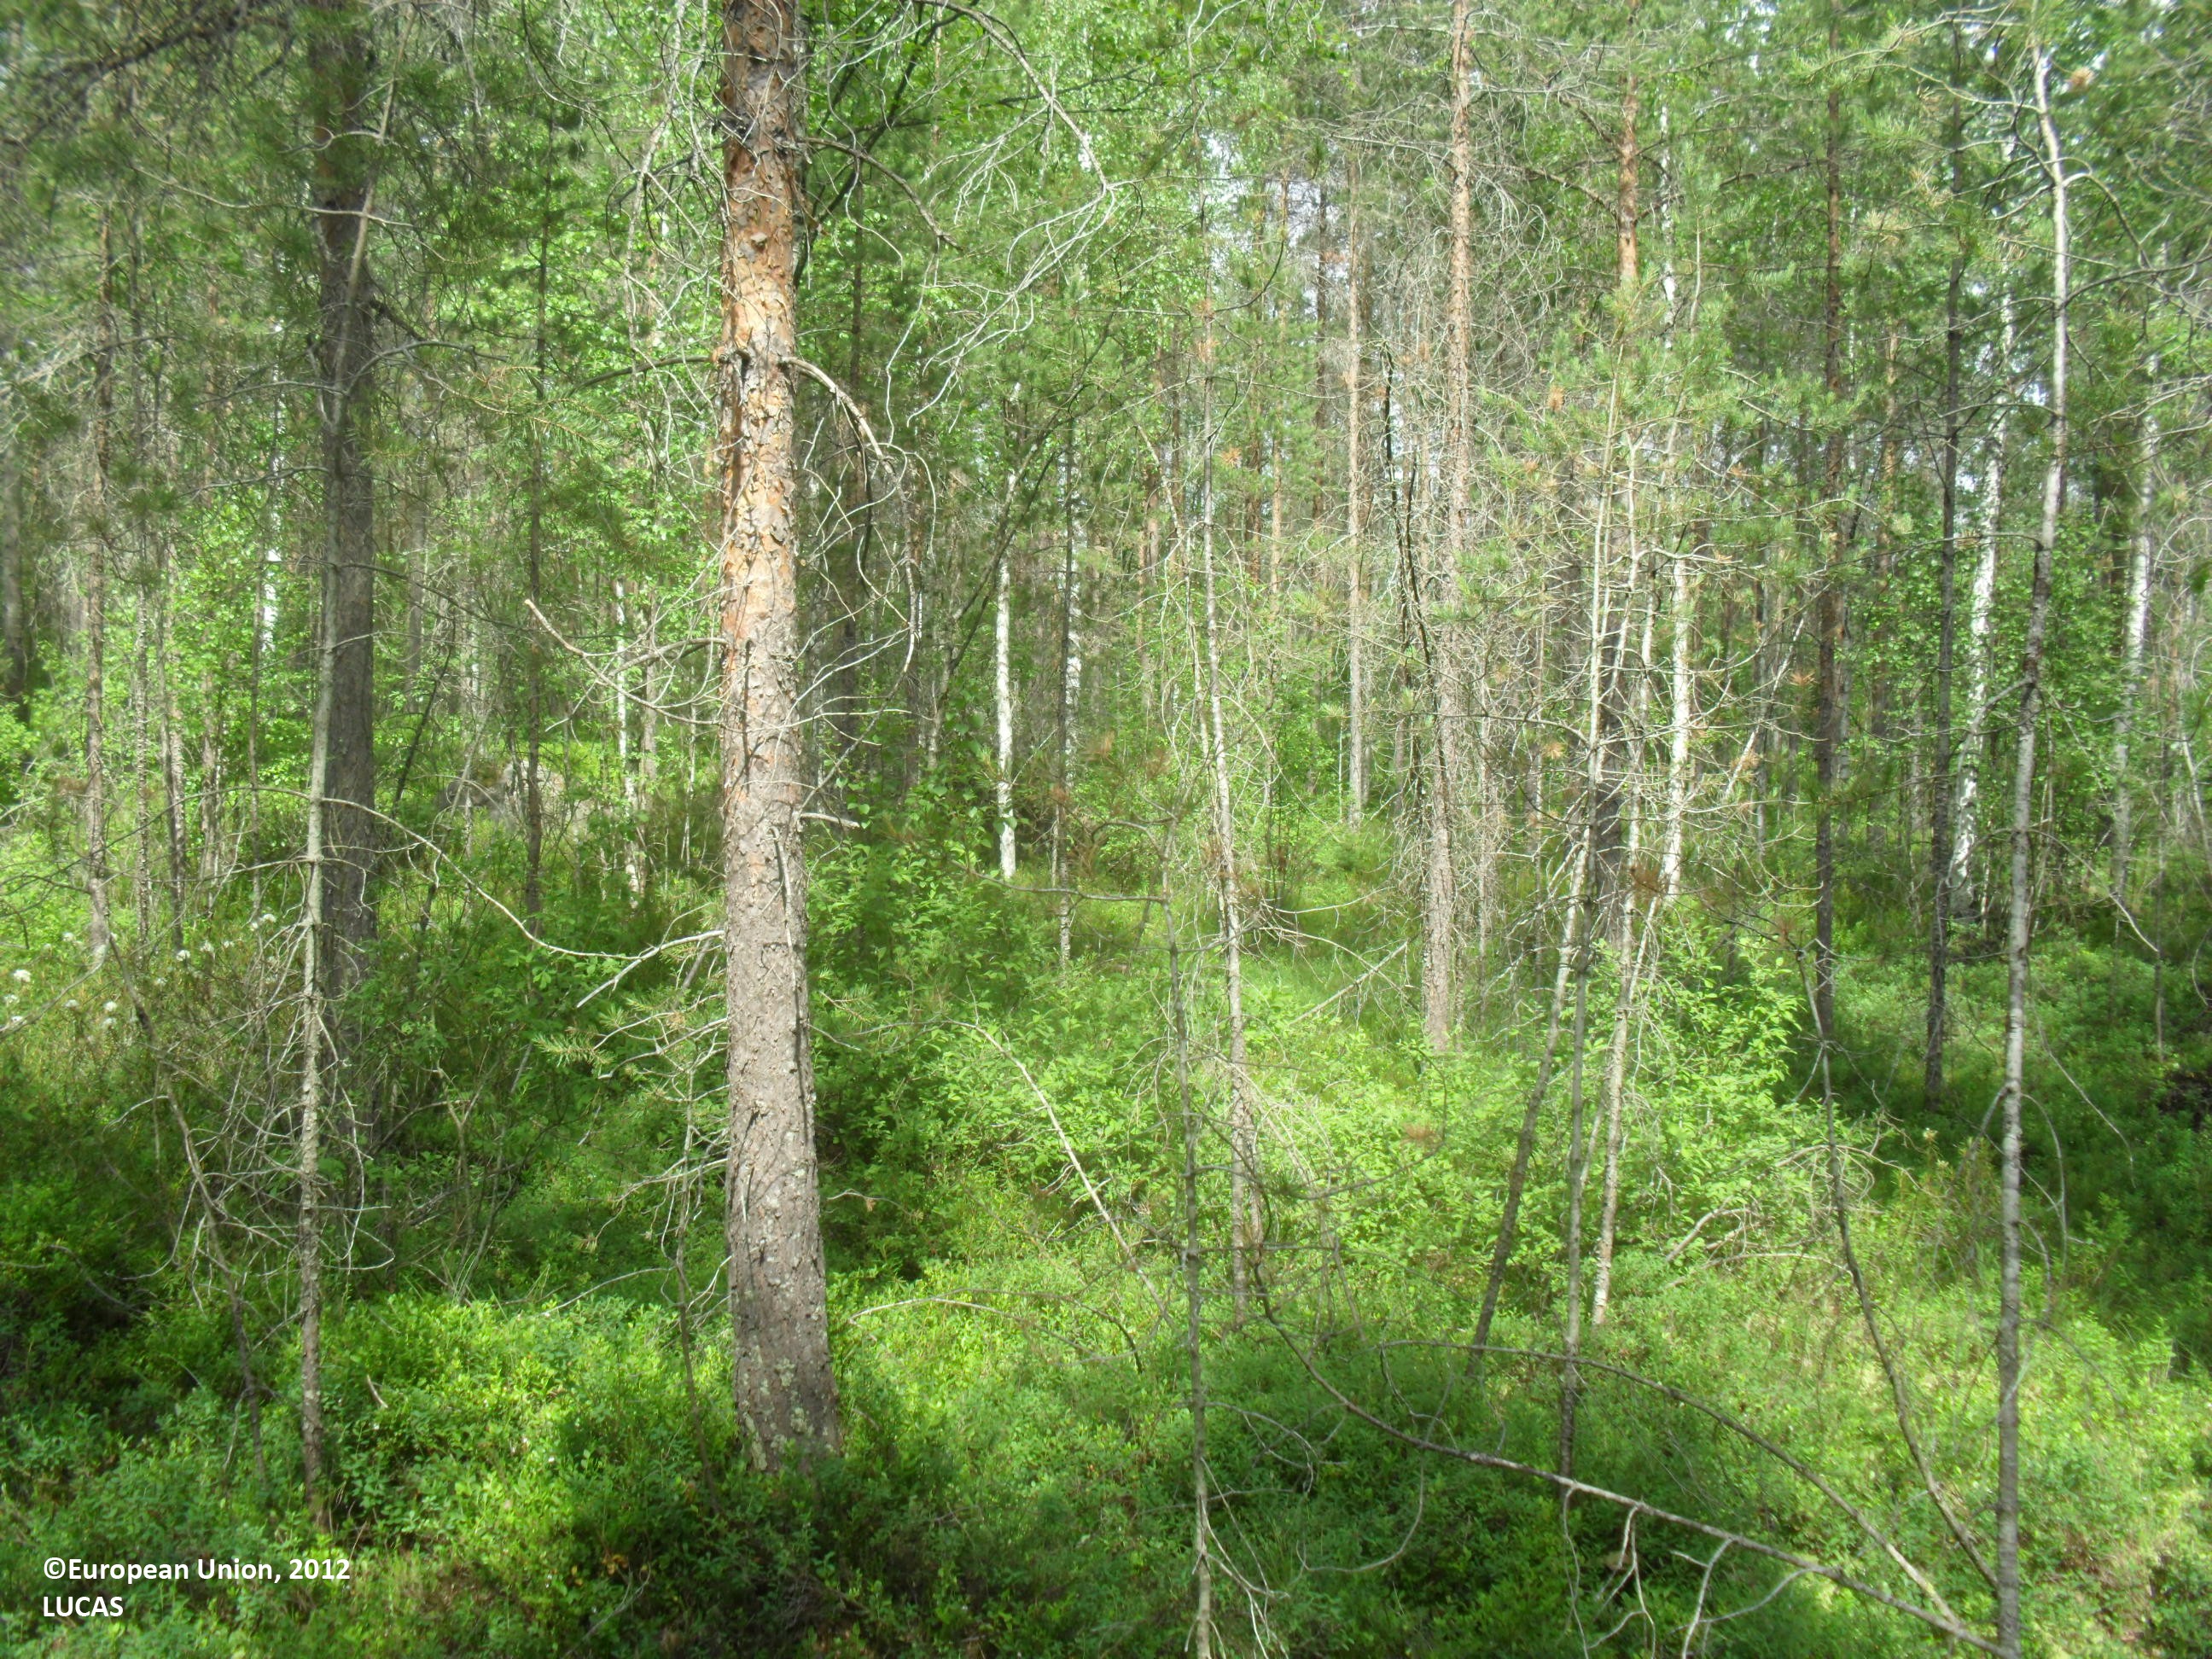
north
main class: Woodland
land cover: Other mixed woodland
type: boreal forest
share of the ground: 50 - 75 %
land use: Forestry
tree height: > 5 m
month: July
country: FI
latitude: 63.5797
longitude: 23.9069
